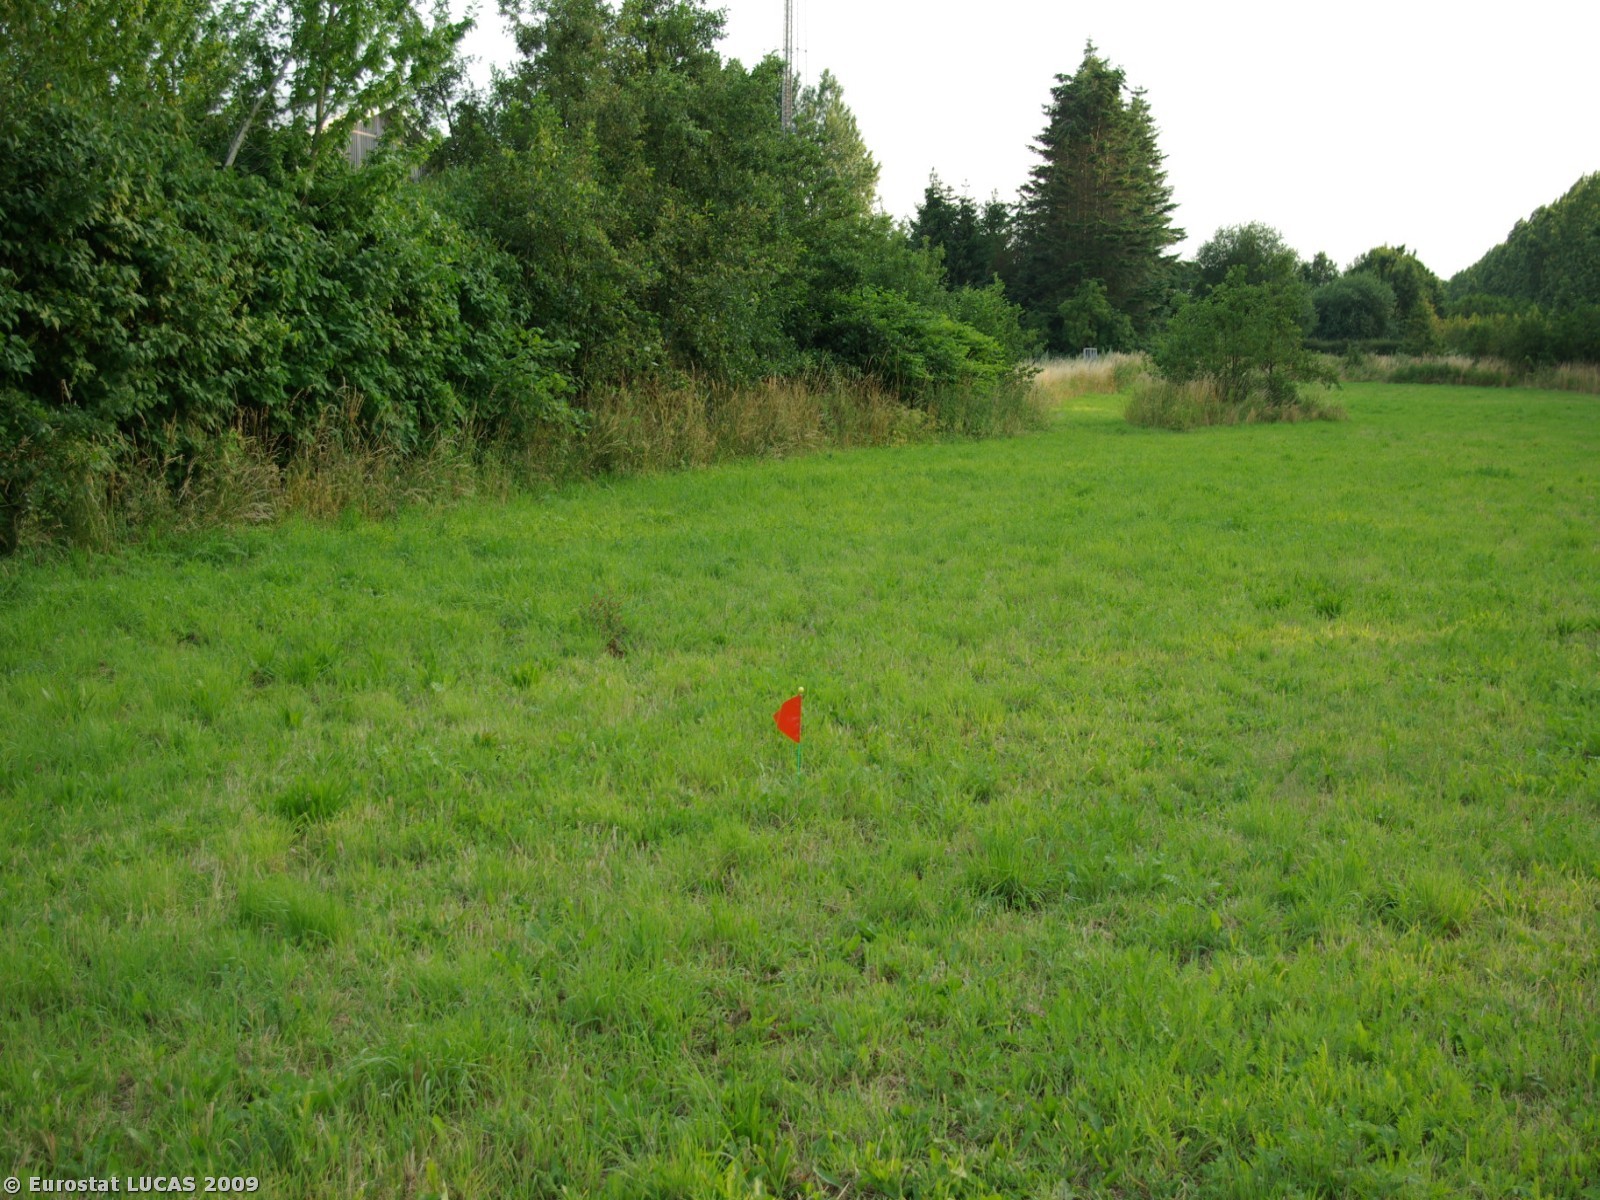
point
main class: Grassland
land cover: Grassland without tree/shrub cover
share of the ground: > 75 %
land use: Agriculture (excluding fallow land and kitchen gardens)
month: July
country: DK
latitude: 54.9294
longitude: 9.7973
